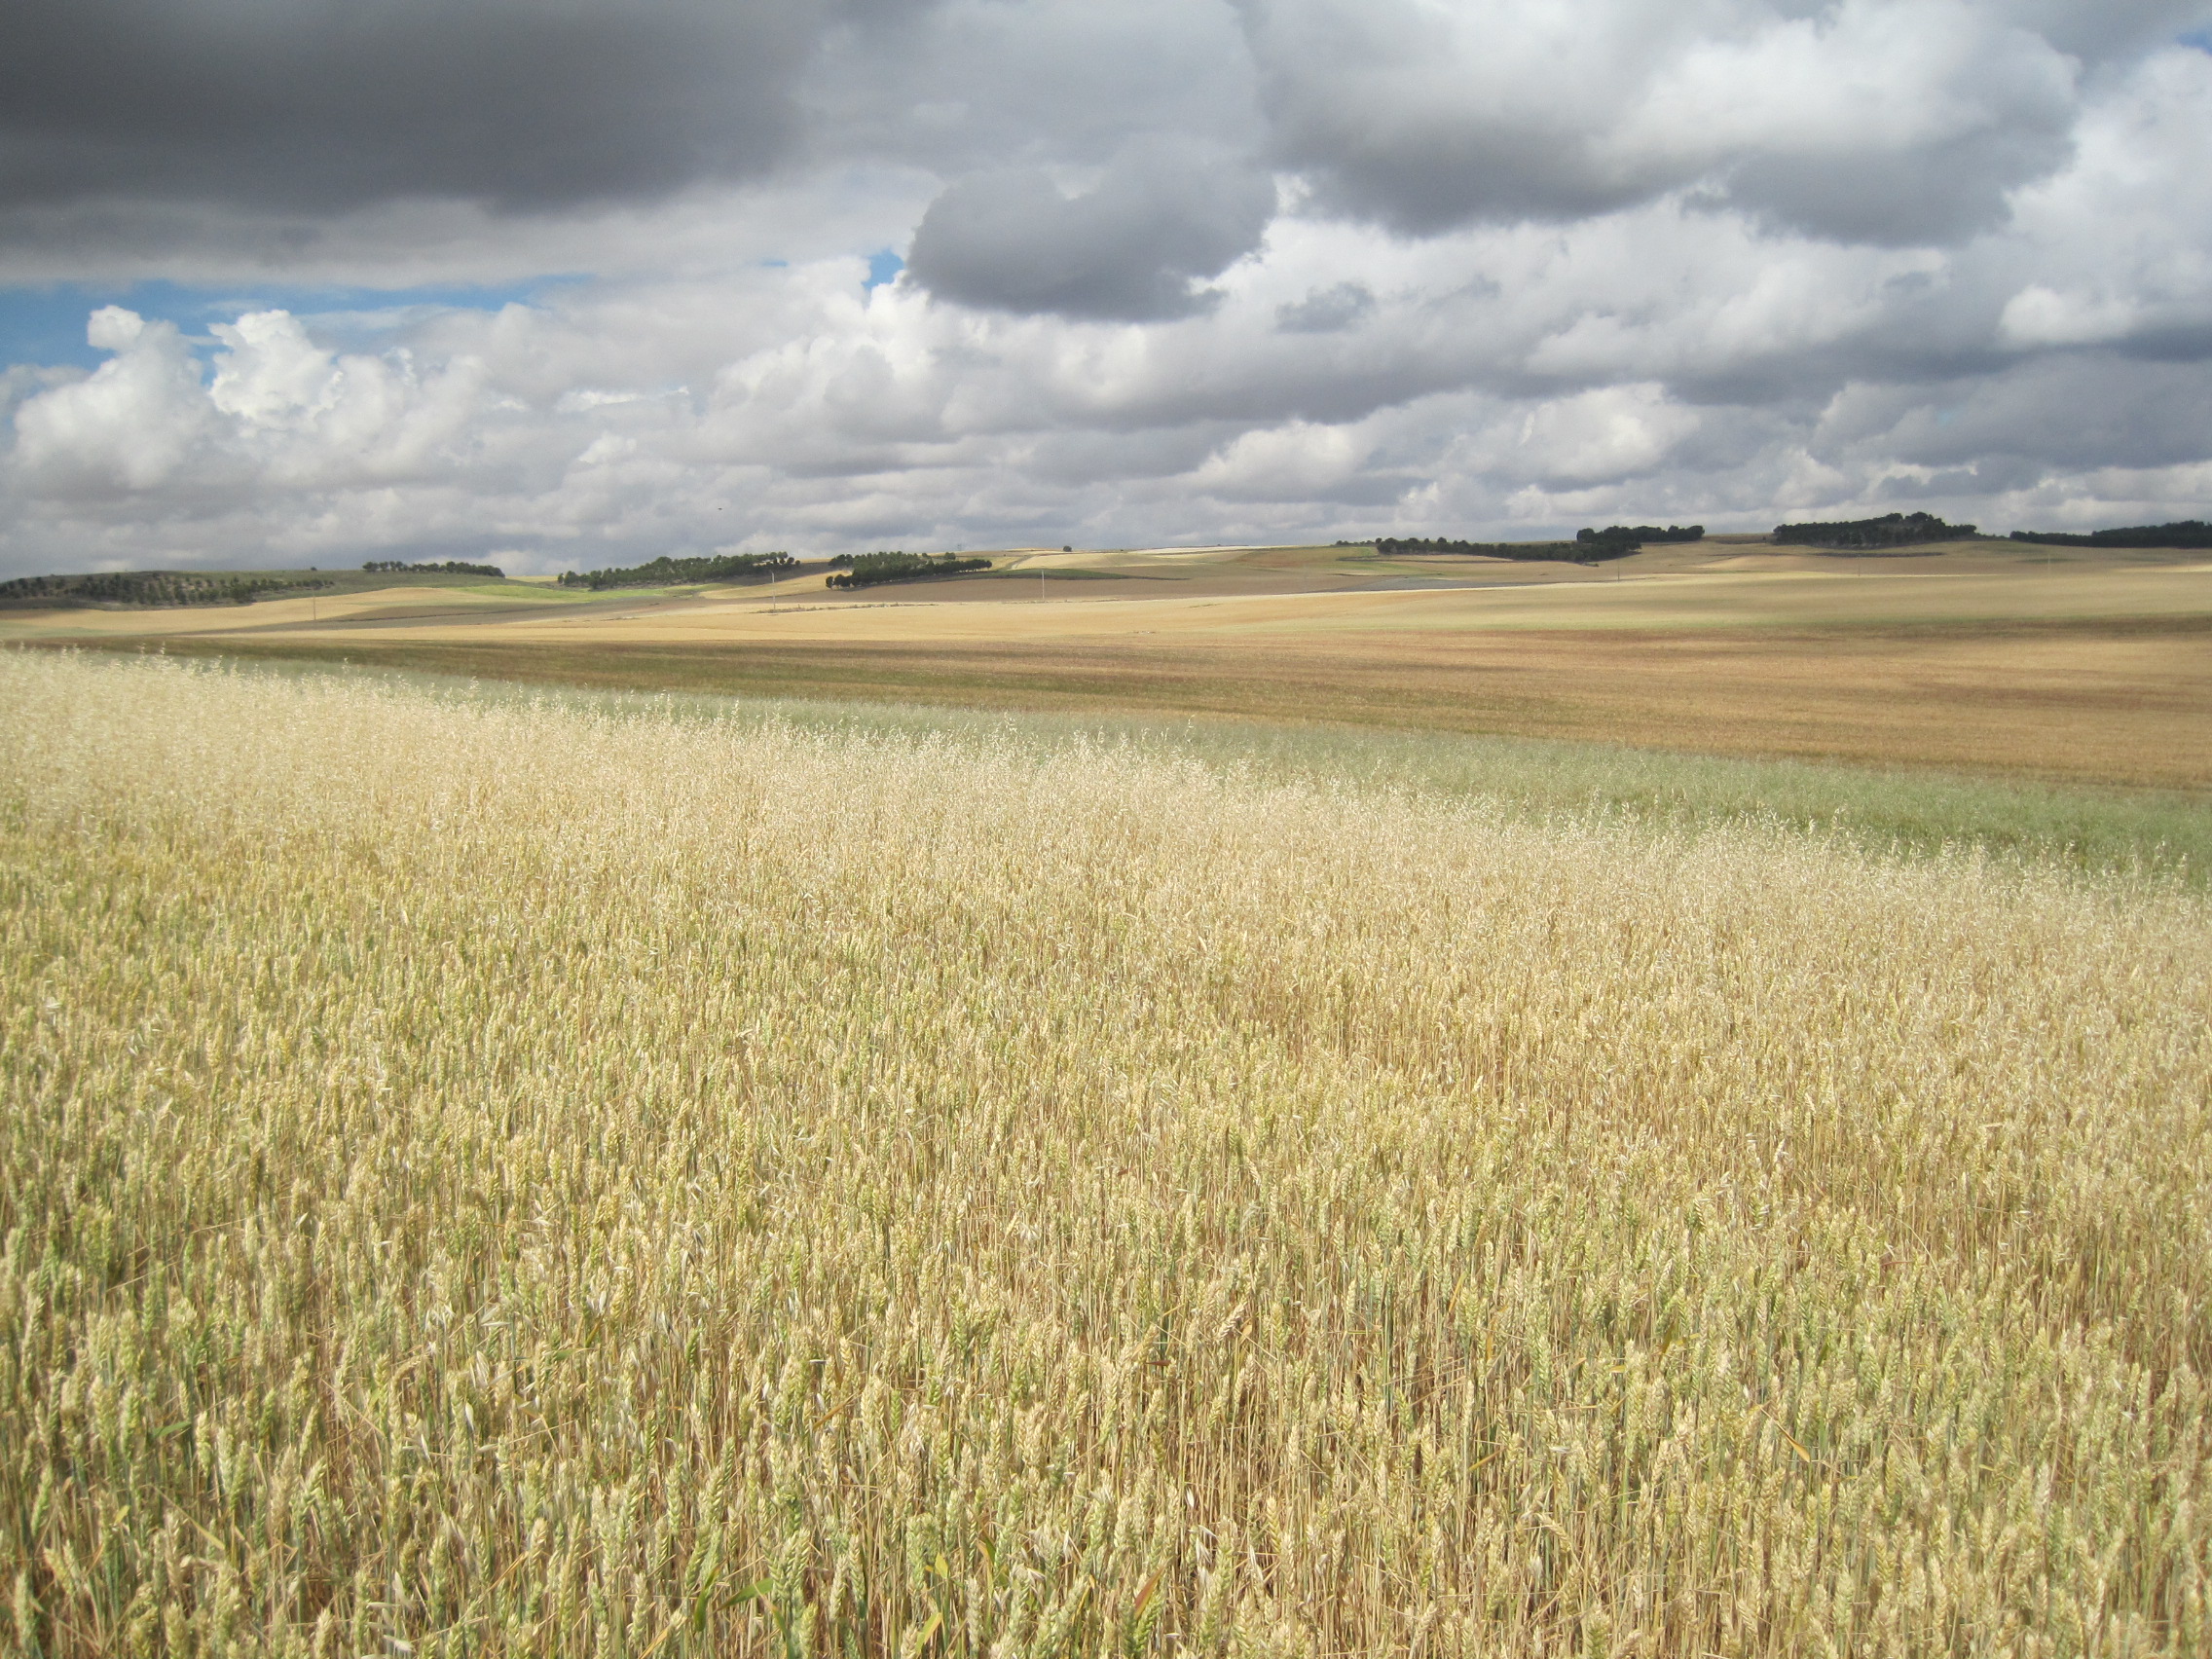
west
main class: Cropland
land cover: Common wheat
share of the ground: > 75 %
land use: Agriculture (excluding fallow land and kitchen gardens)
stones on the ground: 10 - 25 %
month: June
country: ES
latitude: 41.7747
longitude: -4.7115
